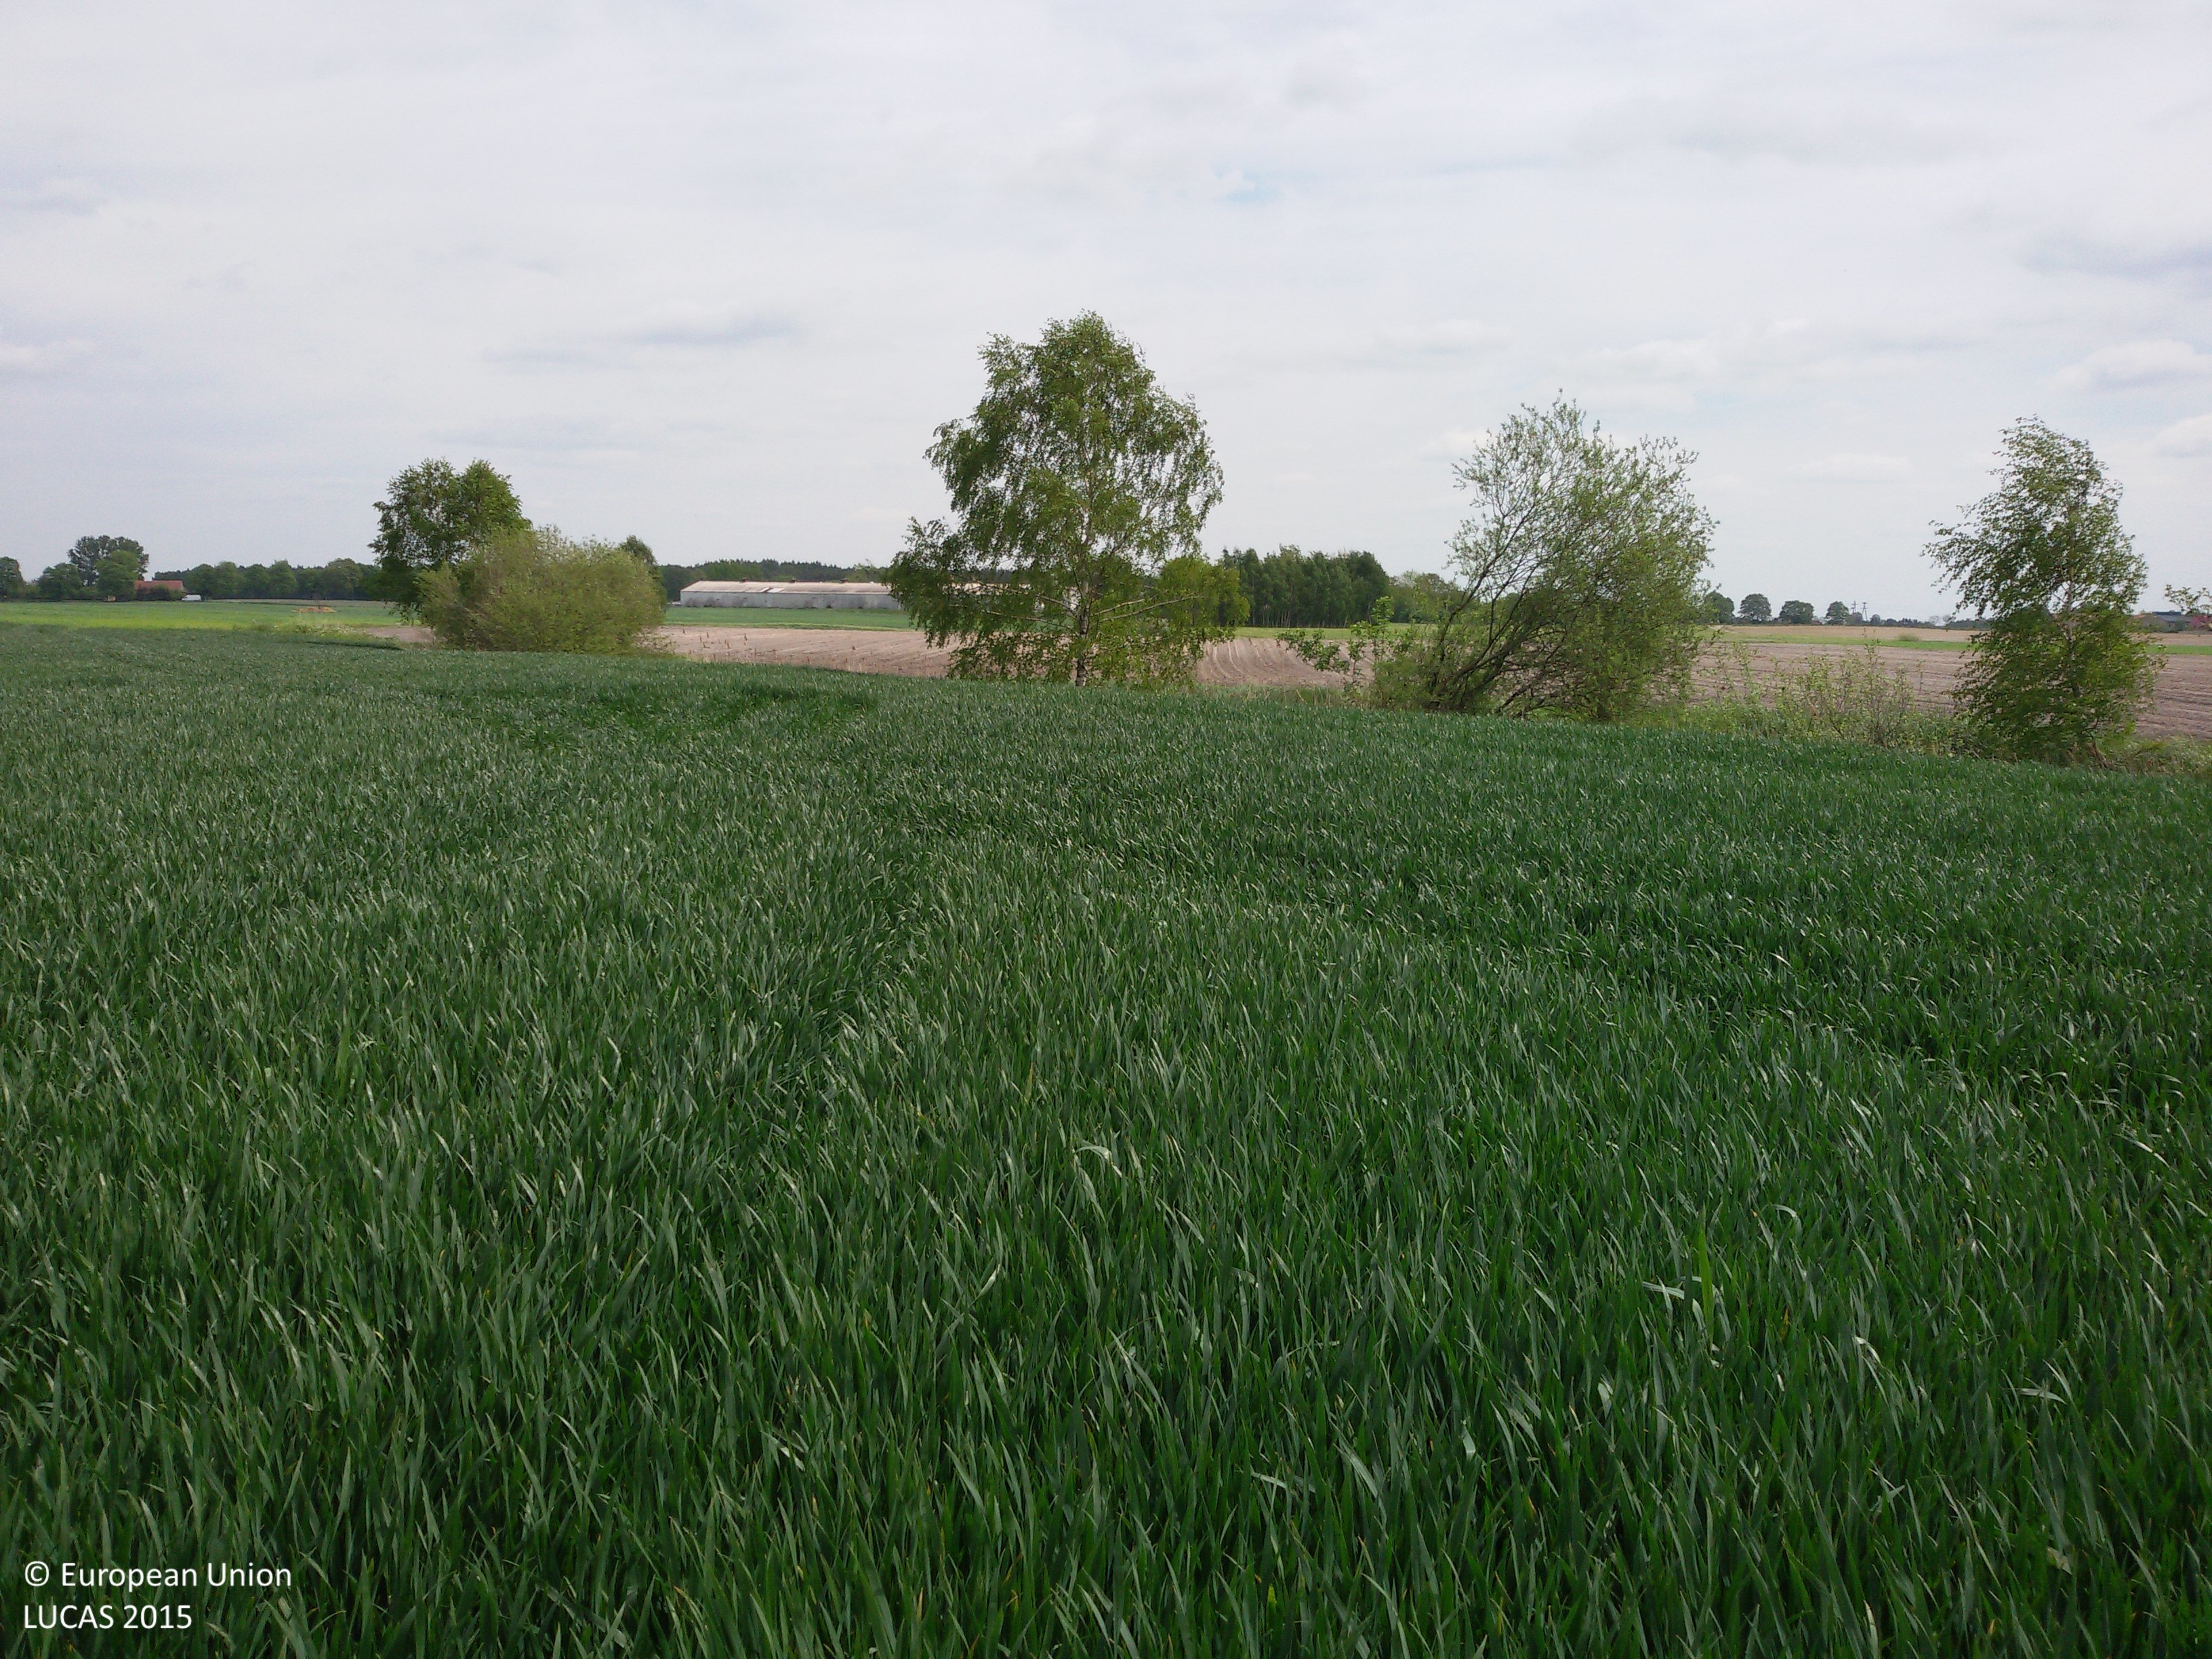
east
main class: Cropland
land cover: Triticale
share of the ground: > 75 %
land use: Agriculture (excluding fallow land and kitchen gardens)
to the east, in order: Triticale; Abandoned hedges; Ditches and canals; Other bare soil
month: May
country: PL
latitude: 52.8636
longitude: 17.1849
